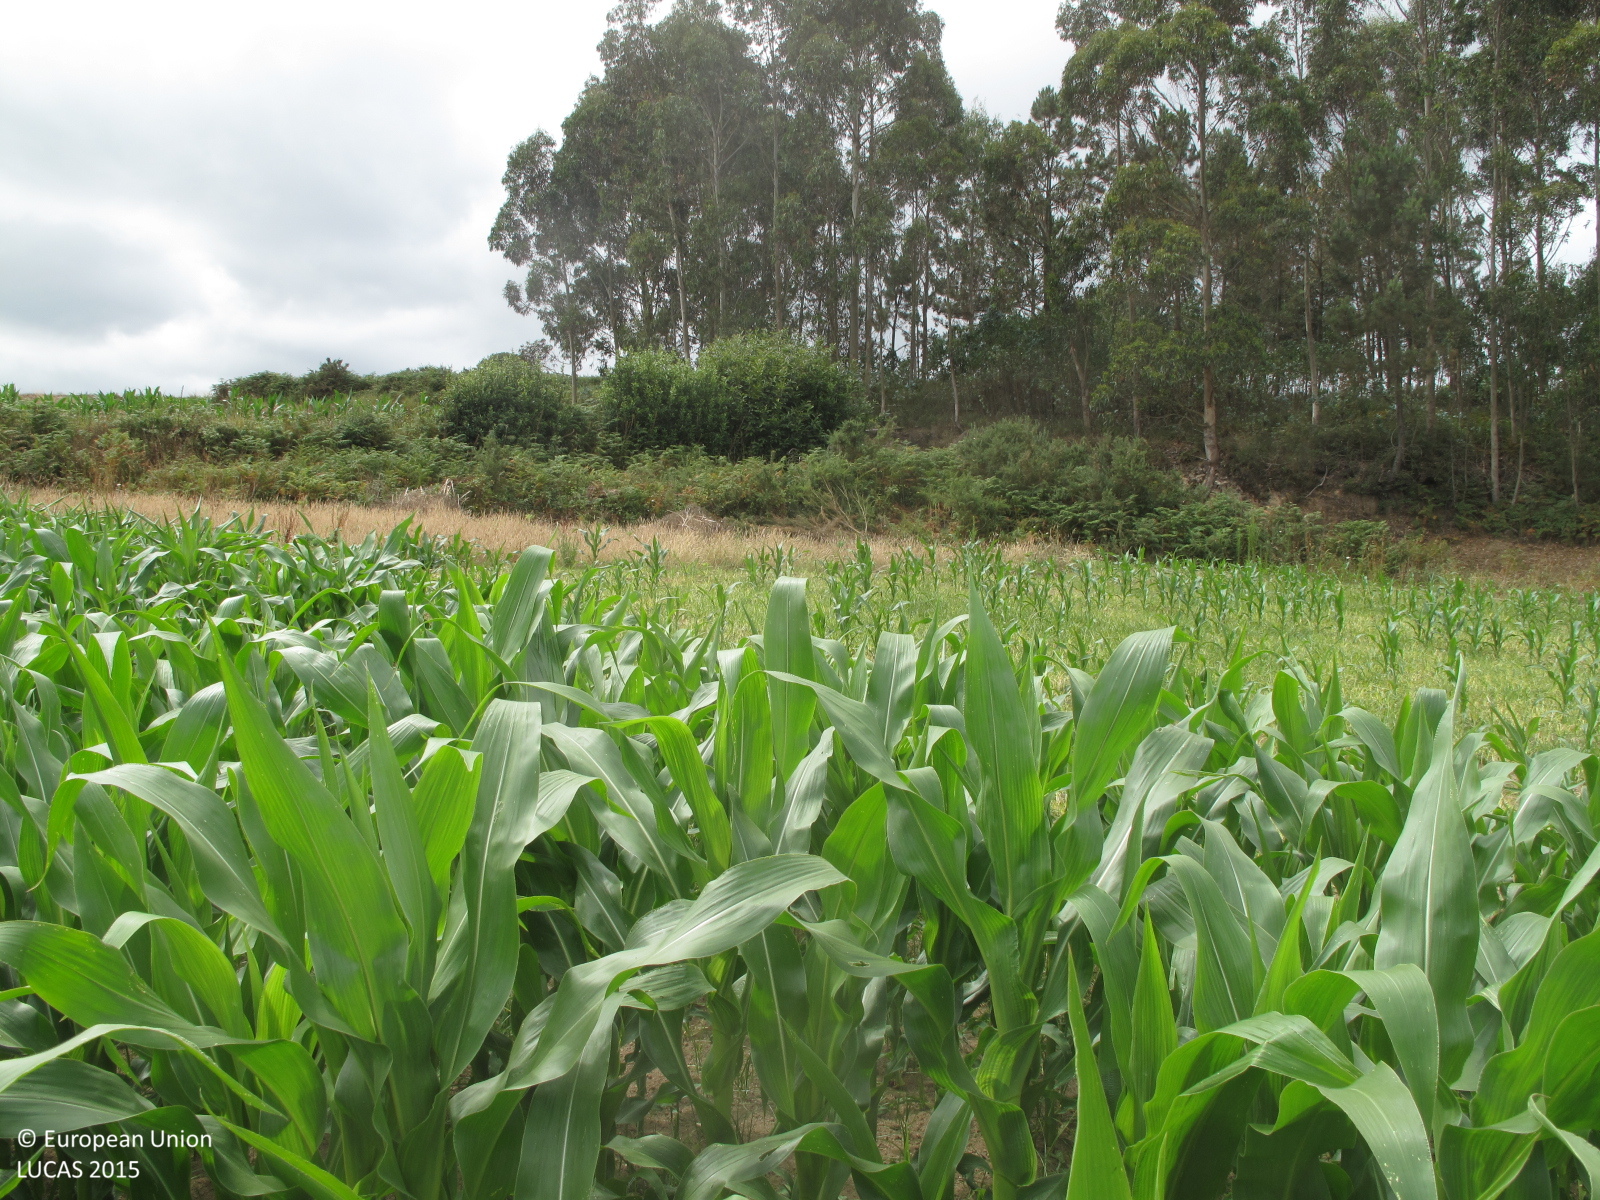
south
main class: Cropland
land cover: Maize
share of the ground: > 75 %
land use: Agriculture (excluding fallow land and kitchen gardens)
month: July
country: ES
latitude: 43.2857
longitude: -8.6615
